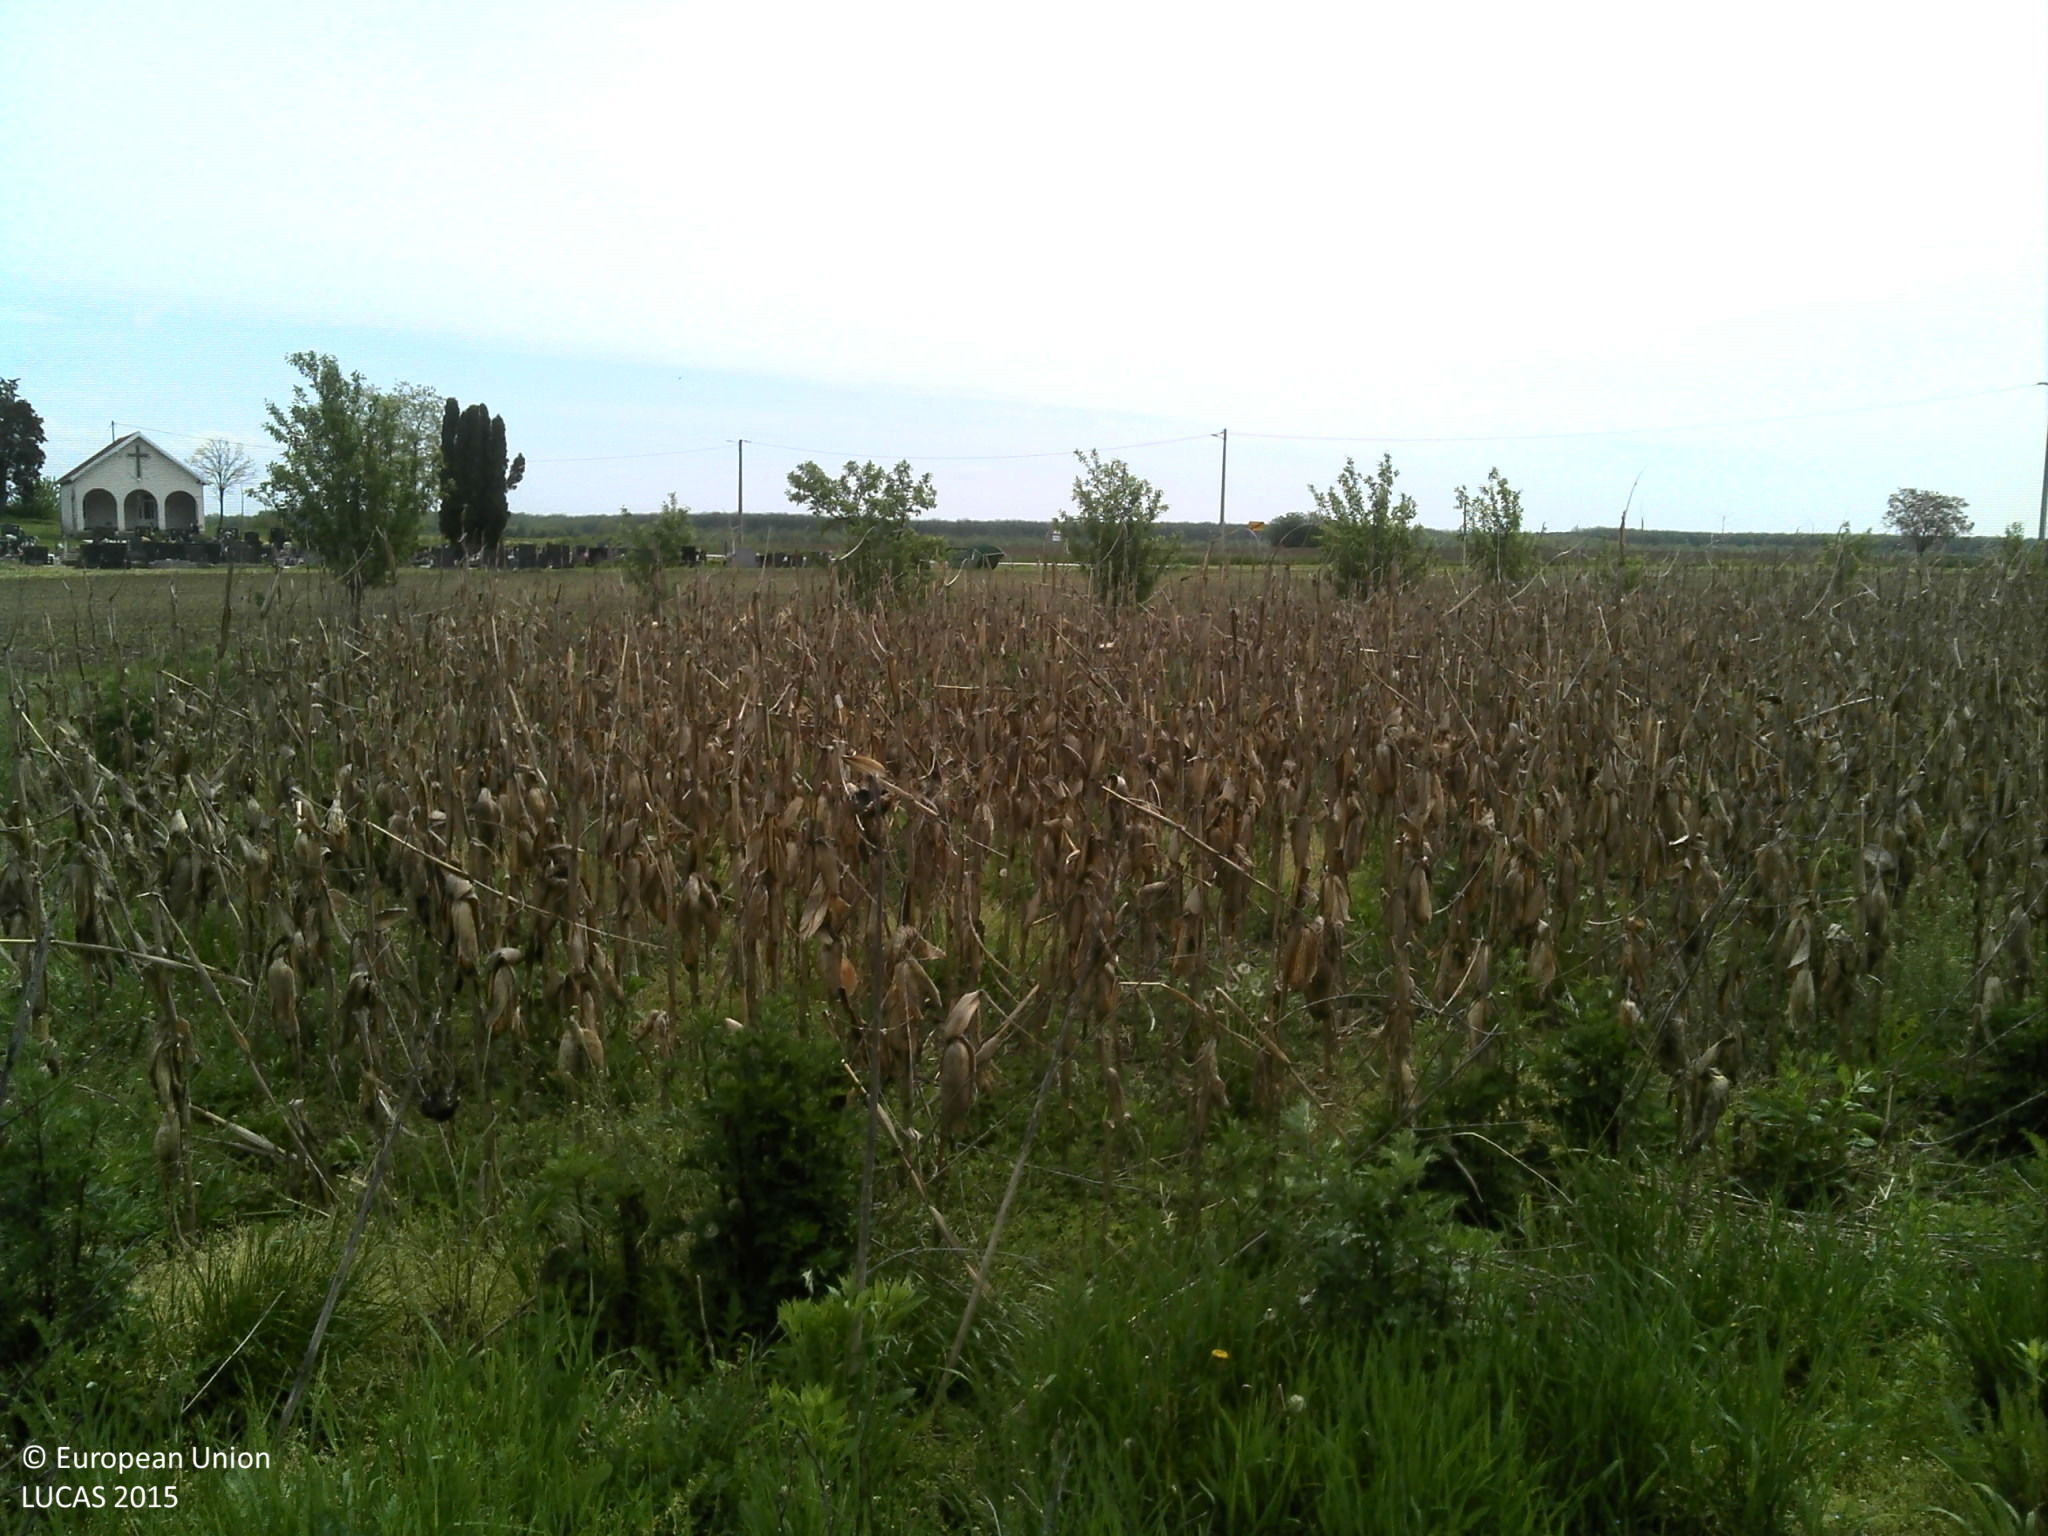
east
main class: Cropland
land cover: Other fruit trees and berries
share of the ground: > 75 %
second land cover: Spontaneously vegetated surfaces
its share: > 75 %
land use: Agriculture (excluding fallow land and kitchen gardens)
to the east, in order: Other fruit trees and berries; Spontaneously vegetated surfaces; Maize; Lines of trees; Grass margins; Tracks; Soya; Maize; Grass margins; Tracks; Grass margins; Tracks; Grass margins; Electric lines; Soya; Maize
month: May
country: HR
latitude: 45.2383
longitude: 19.0916
